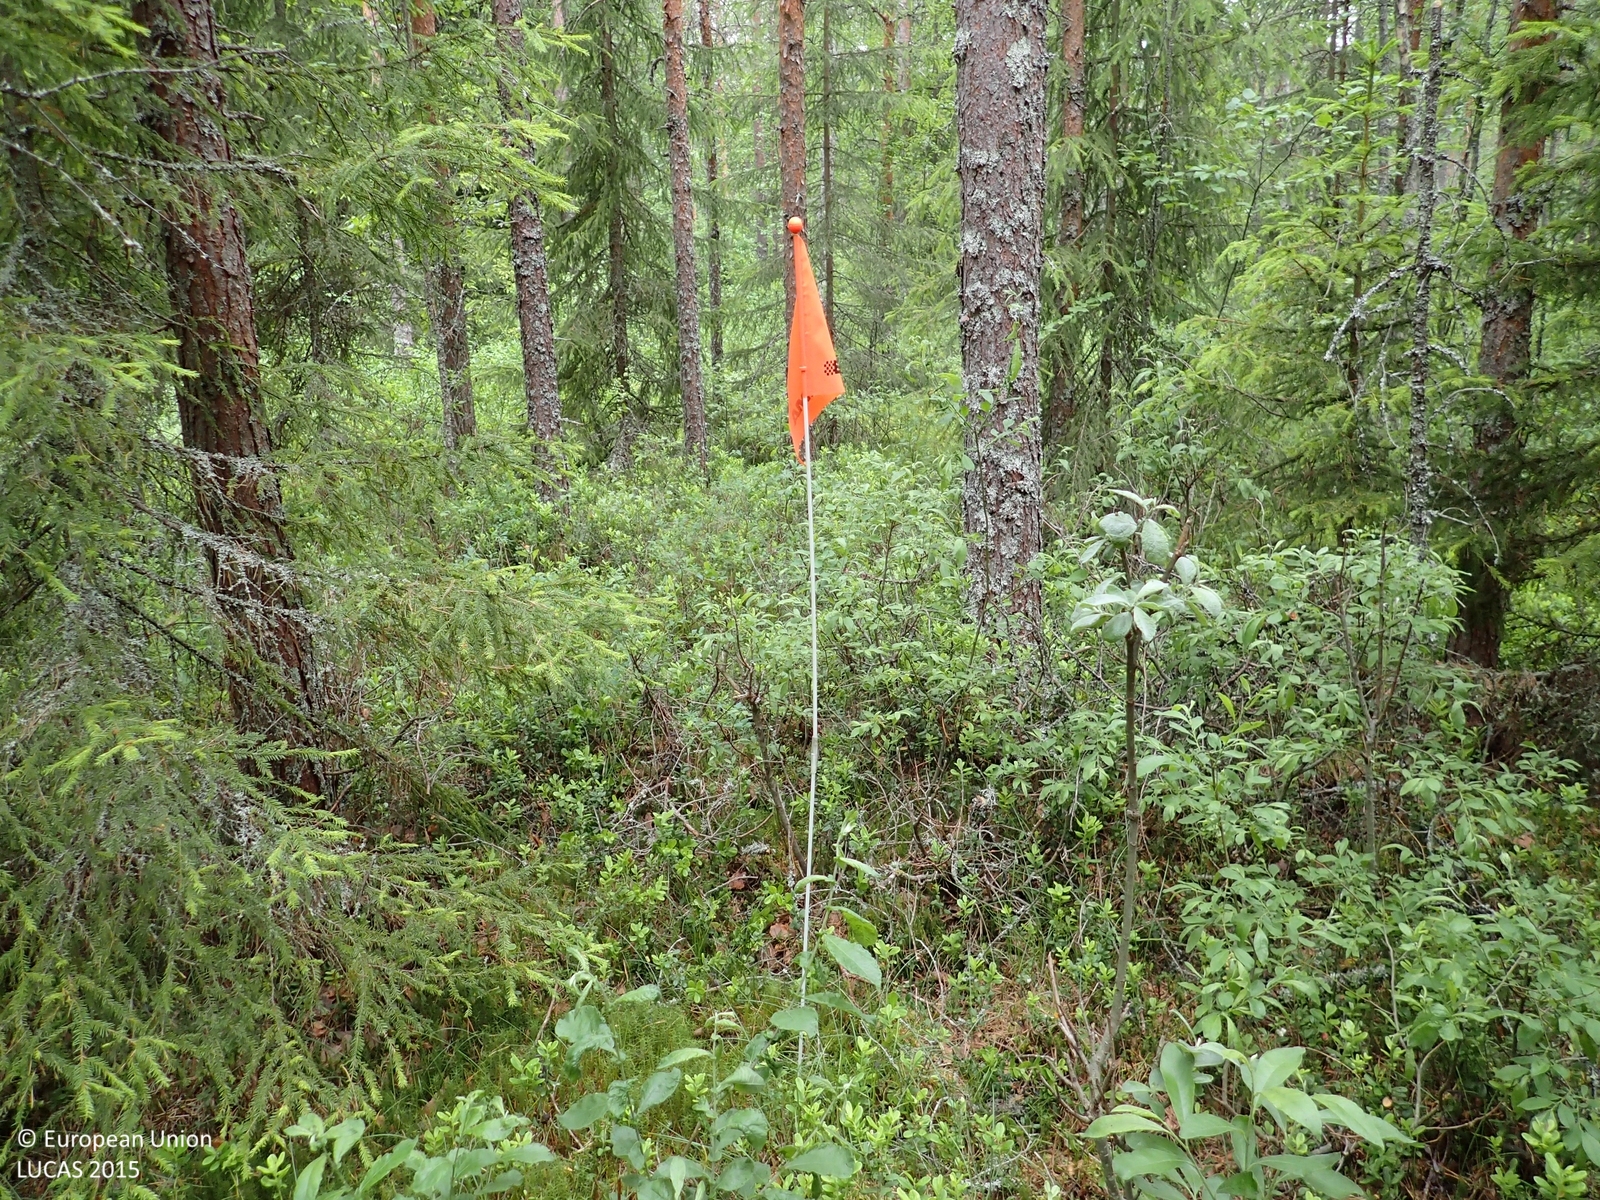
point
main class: Woodland
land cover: Pine dominated coniferous woodland
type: mire and swamp forests
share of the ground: > 75 %
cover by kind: coniferous forest trees 70 %, shrubs 20 %, broadleaved forest trees 5 %, lichens and mosses 5 %
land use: Forestry
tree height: > 5 m
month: July
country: FI
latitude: 62.7194
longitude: 21.4819
